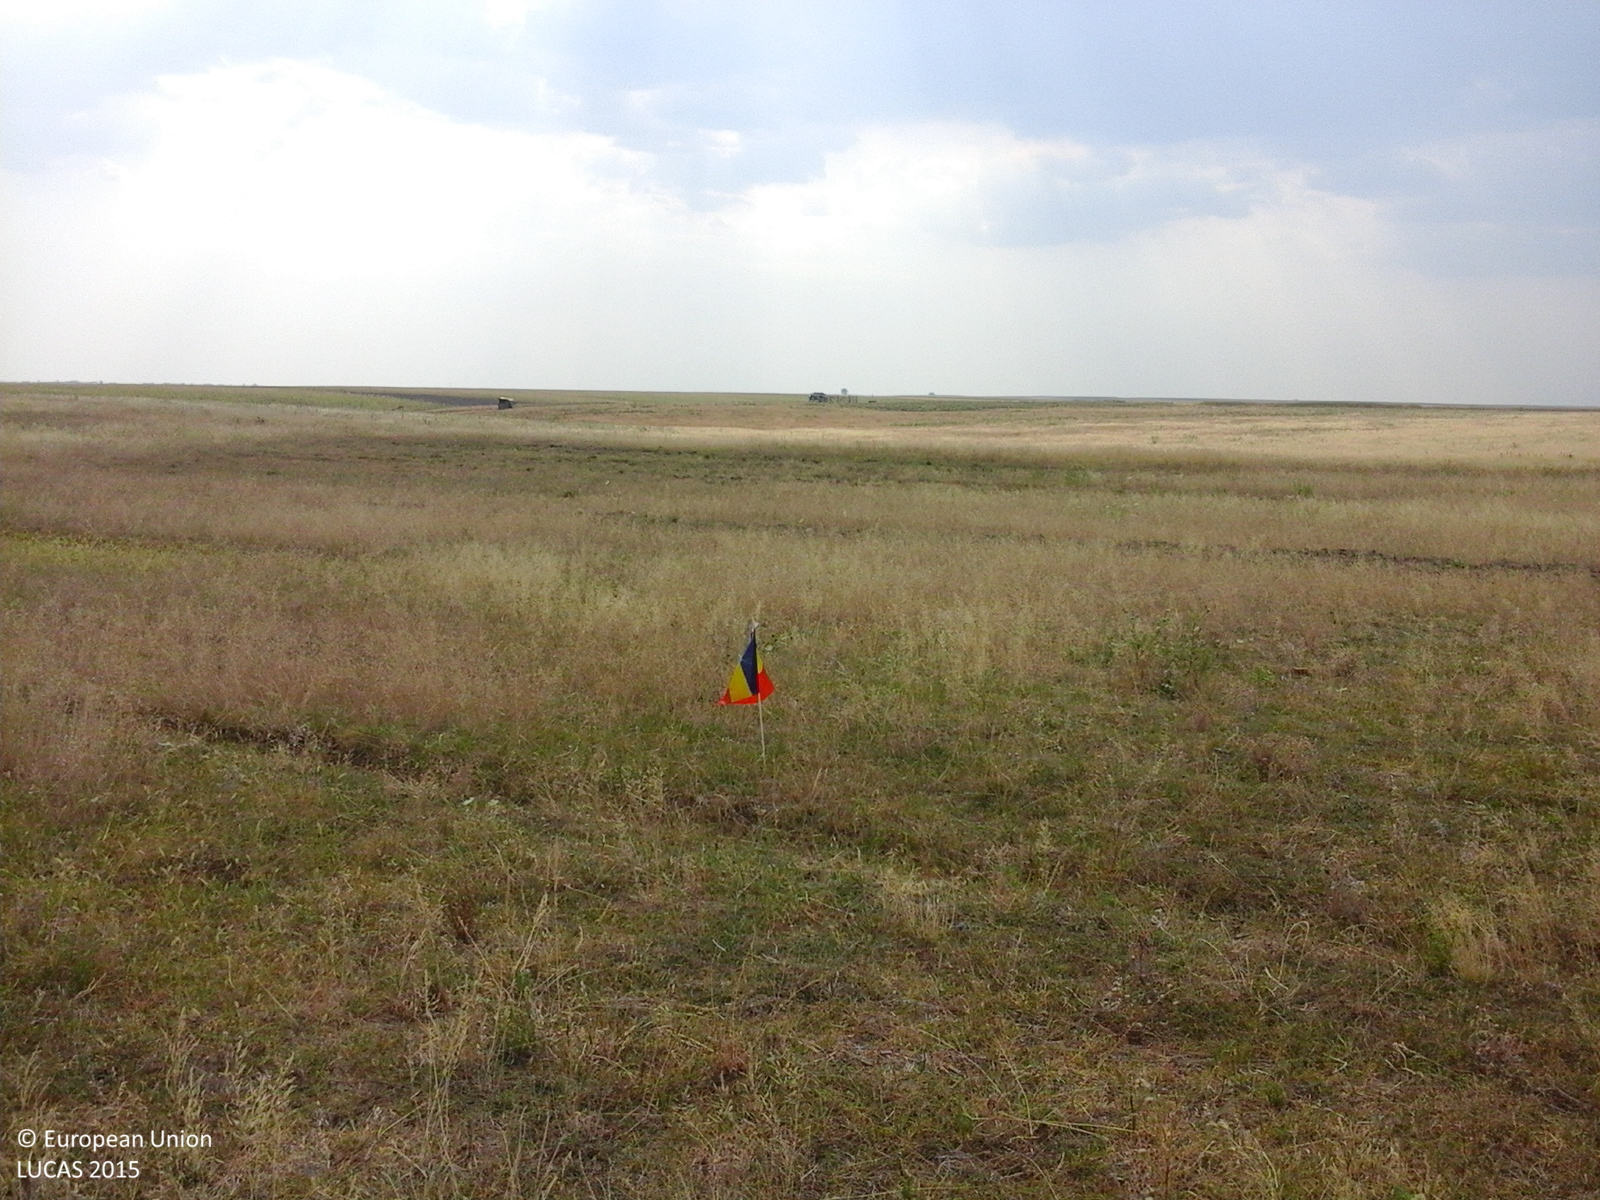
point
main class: Grassland
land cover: Grassland without tree/shrub cover
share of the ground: > 75 %
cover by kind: herbaceous plants 100 %
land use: Agriculture (excluding fallow land and kitchen gardens)
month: August
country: RO
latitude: 44.3131
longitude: 23.1474
